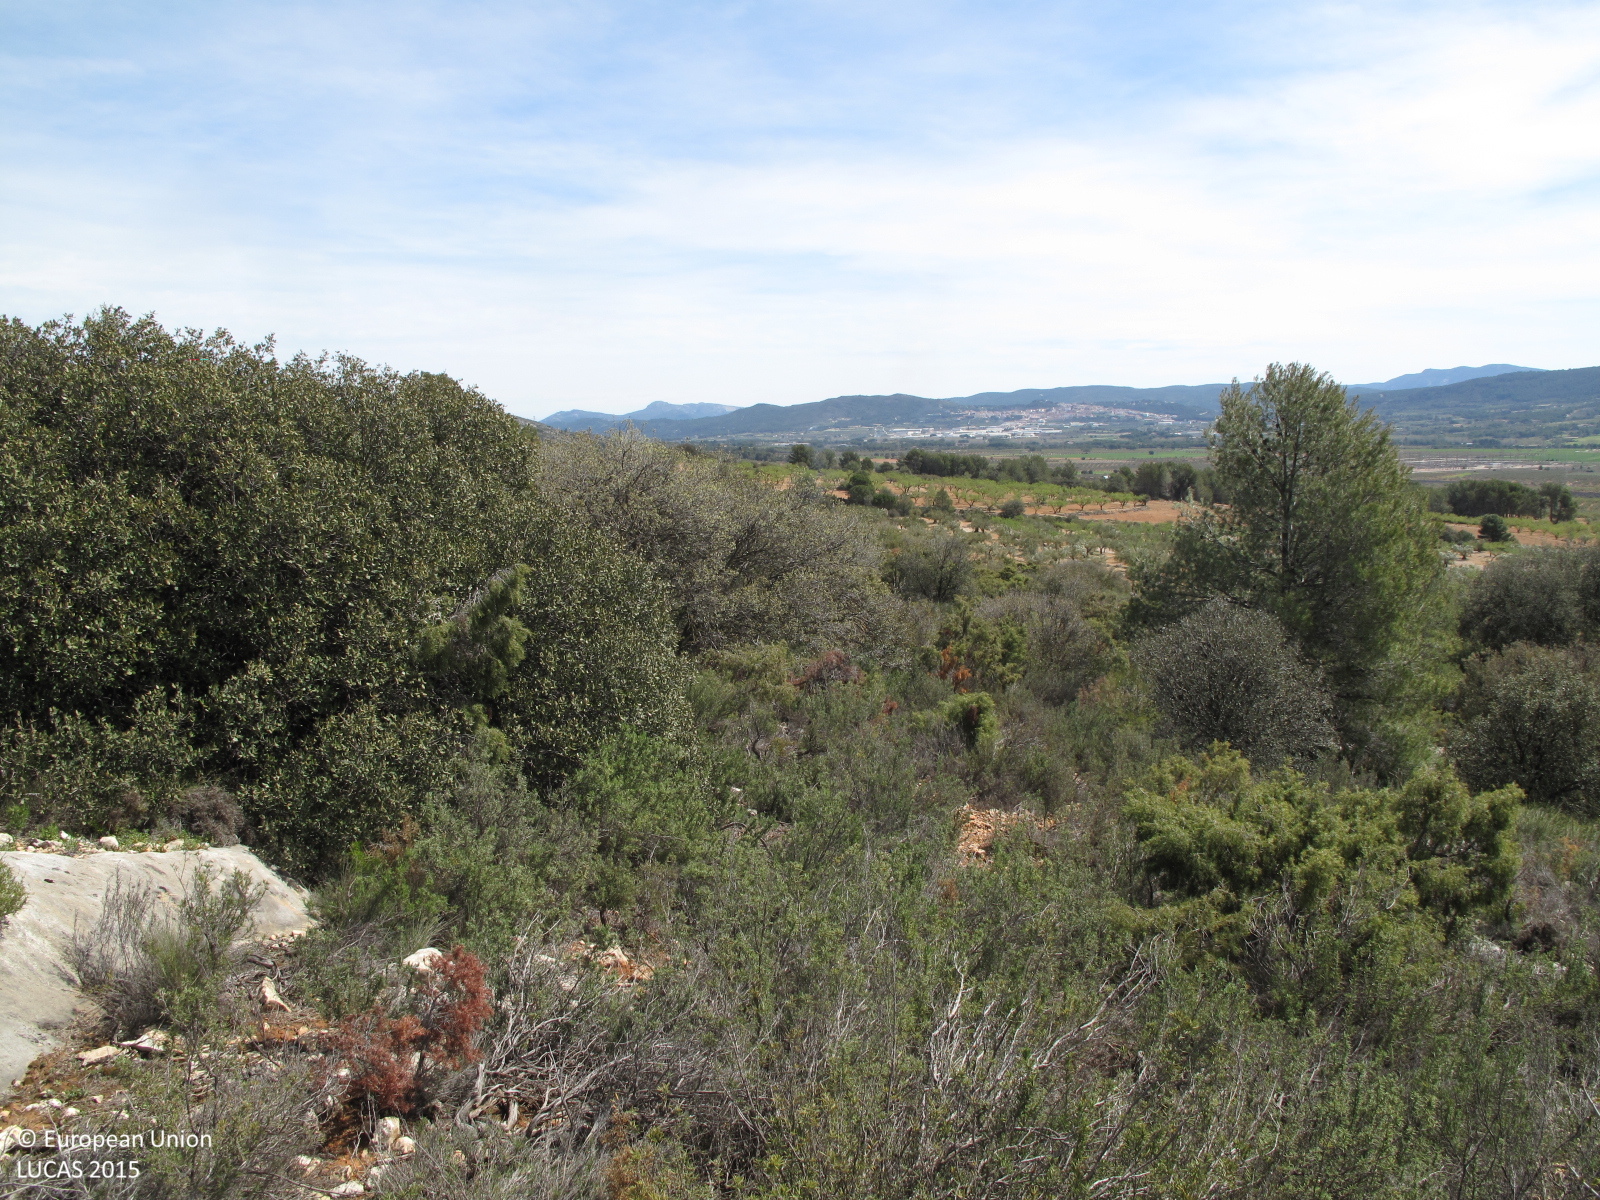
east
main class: Shrubland
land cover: Shrubland with sparse tree cover
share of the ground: 25 - 50 %
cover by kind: herbaceous plants 40 %, shrubs 30 %, consolidated bare surface 25 %, coniferous forest trees 5 %
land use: Semi-natural and natural areas not in use
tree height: > 5 m
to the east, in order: Shrubland with sparse tree cover; Tracks; Olive groves; Shruby margins
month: March
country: ES
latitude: 38.7264
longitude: -0.7456
